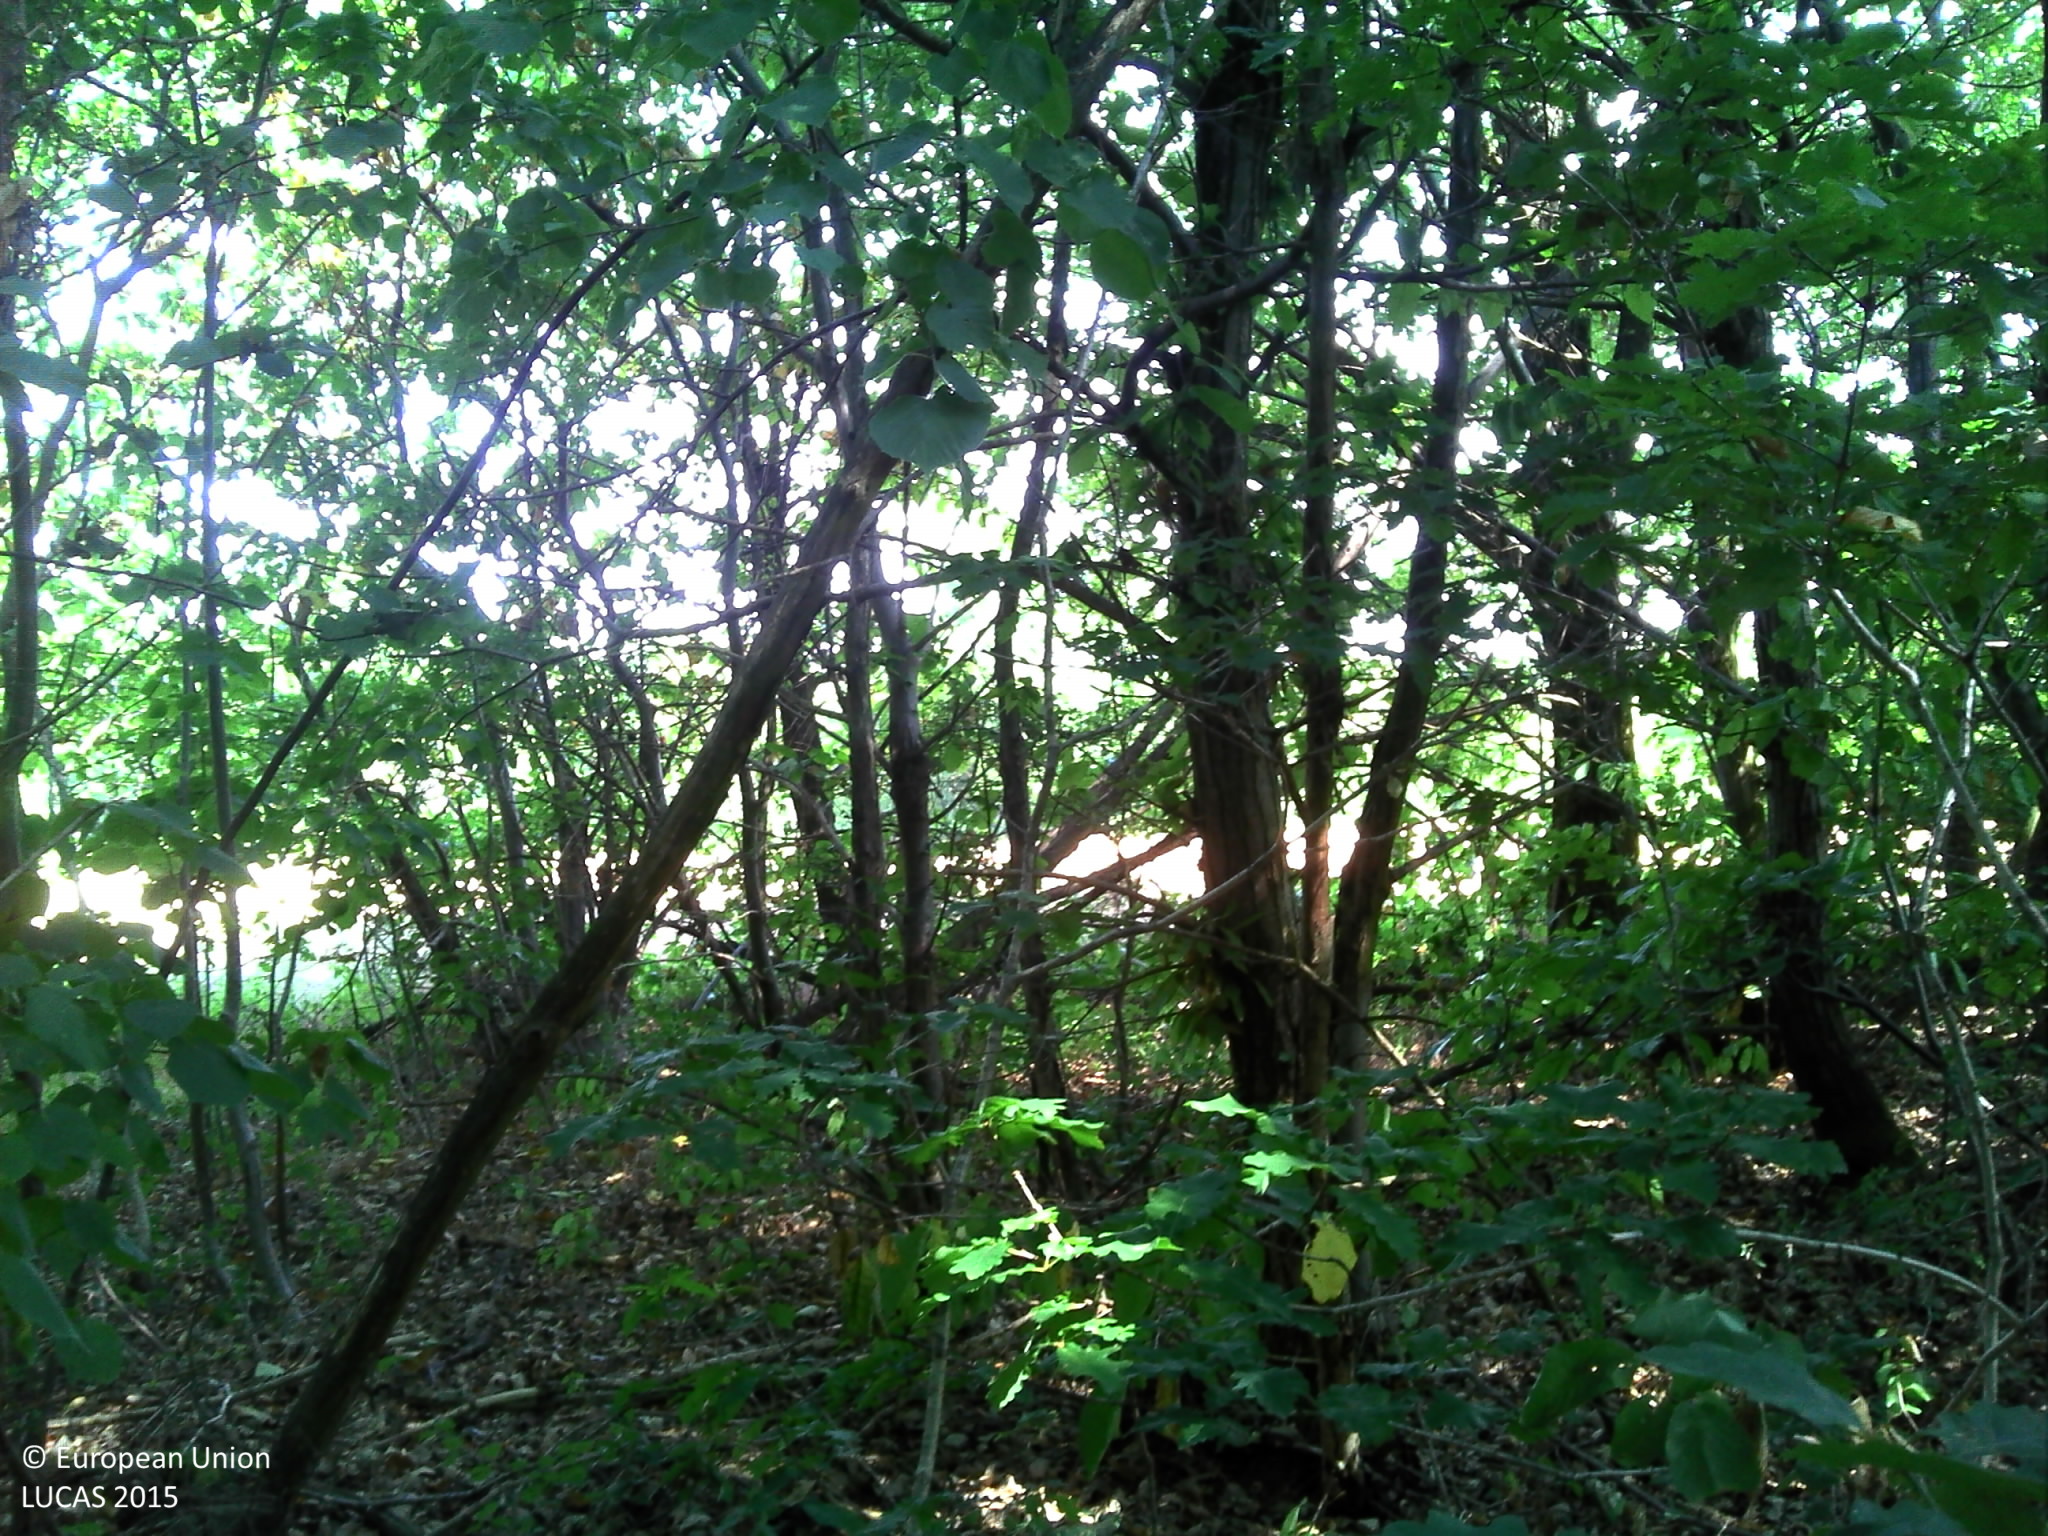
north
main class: Woodland
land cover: Broadleaved woodland
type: mesophytic deciduous forest
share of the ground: > 75 %
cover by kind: broadleaved forest trees 90 %, herbaceous plants 5 %, consolidated bare surface 5 %
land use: Forestry
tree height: > 5 m
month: July
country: FR
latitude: 45.3984
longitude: 4.8819
